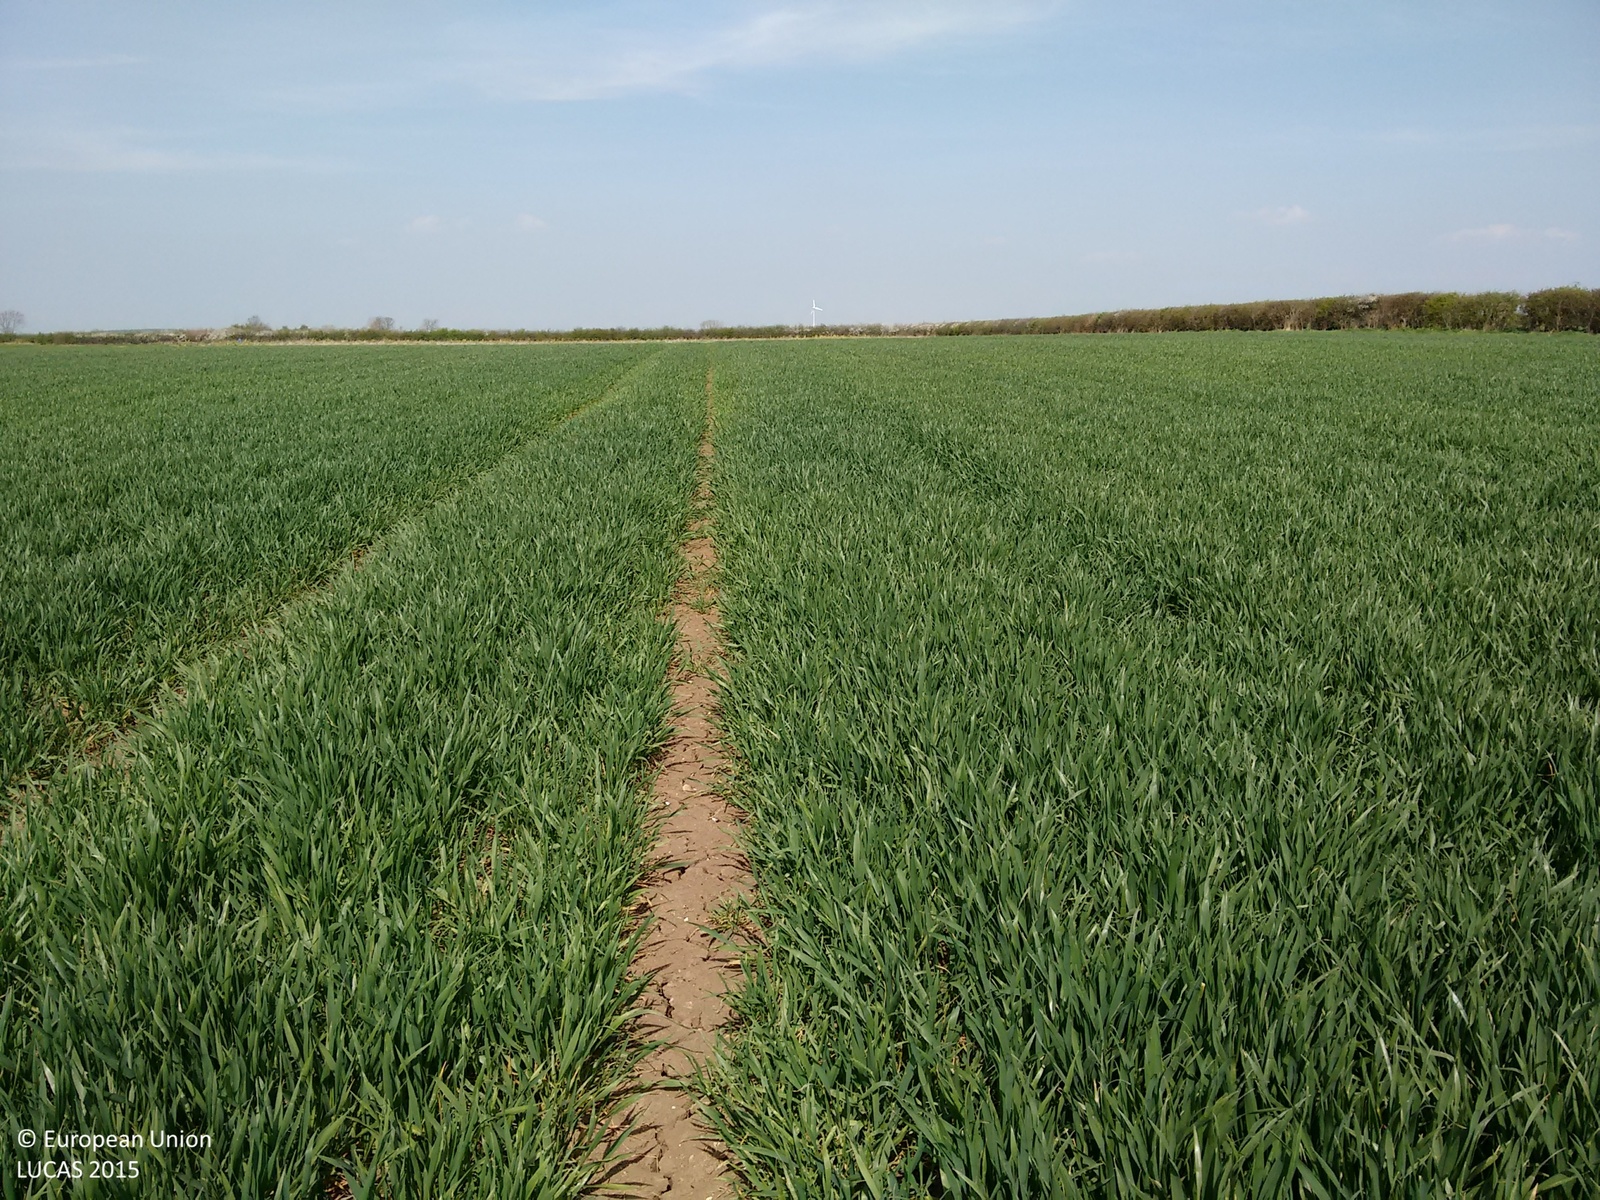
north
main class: Cropland
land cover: Barley
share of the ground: > 75 %
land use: Agriculture (excluding fallow land and kitchen gardens)
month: April
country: GB
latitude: 53.4360
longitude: -0.6818
